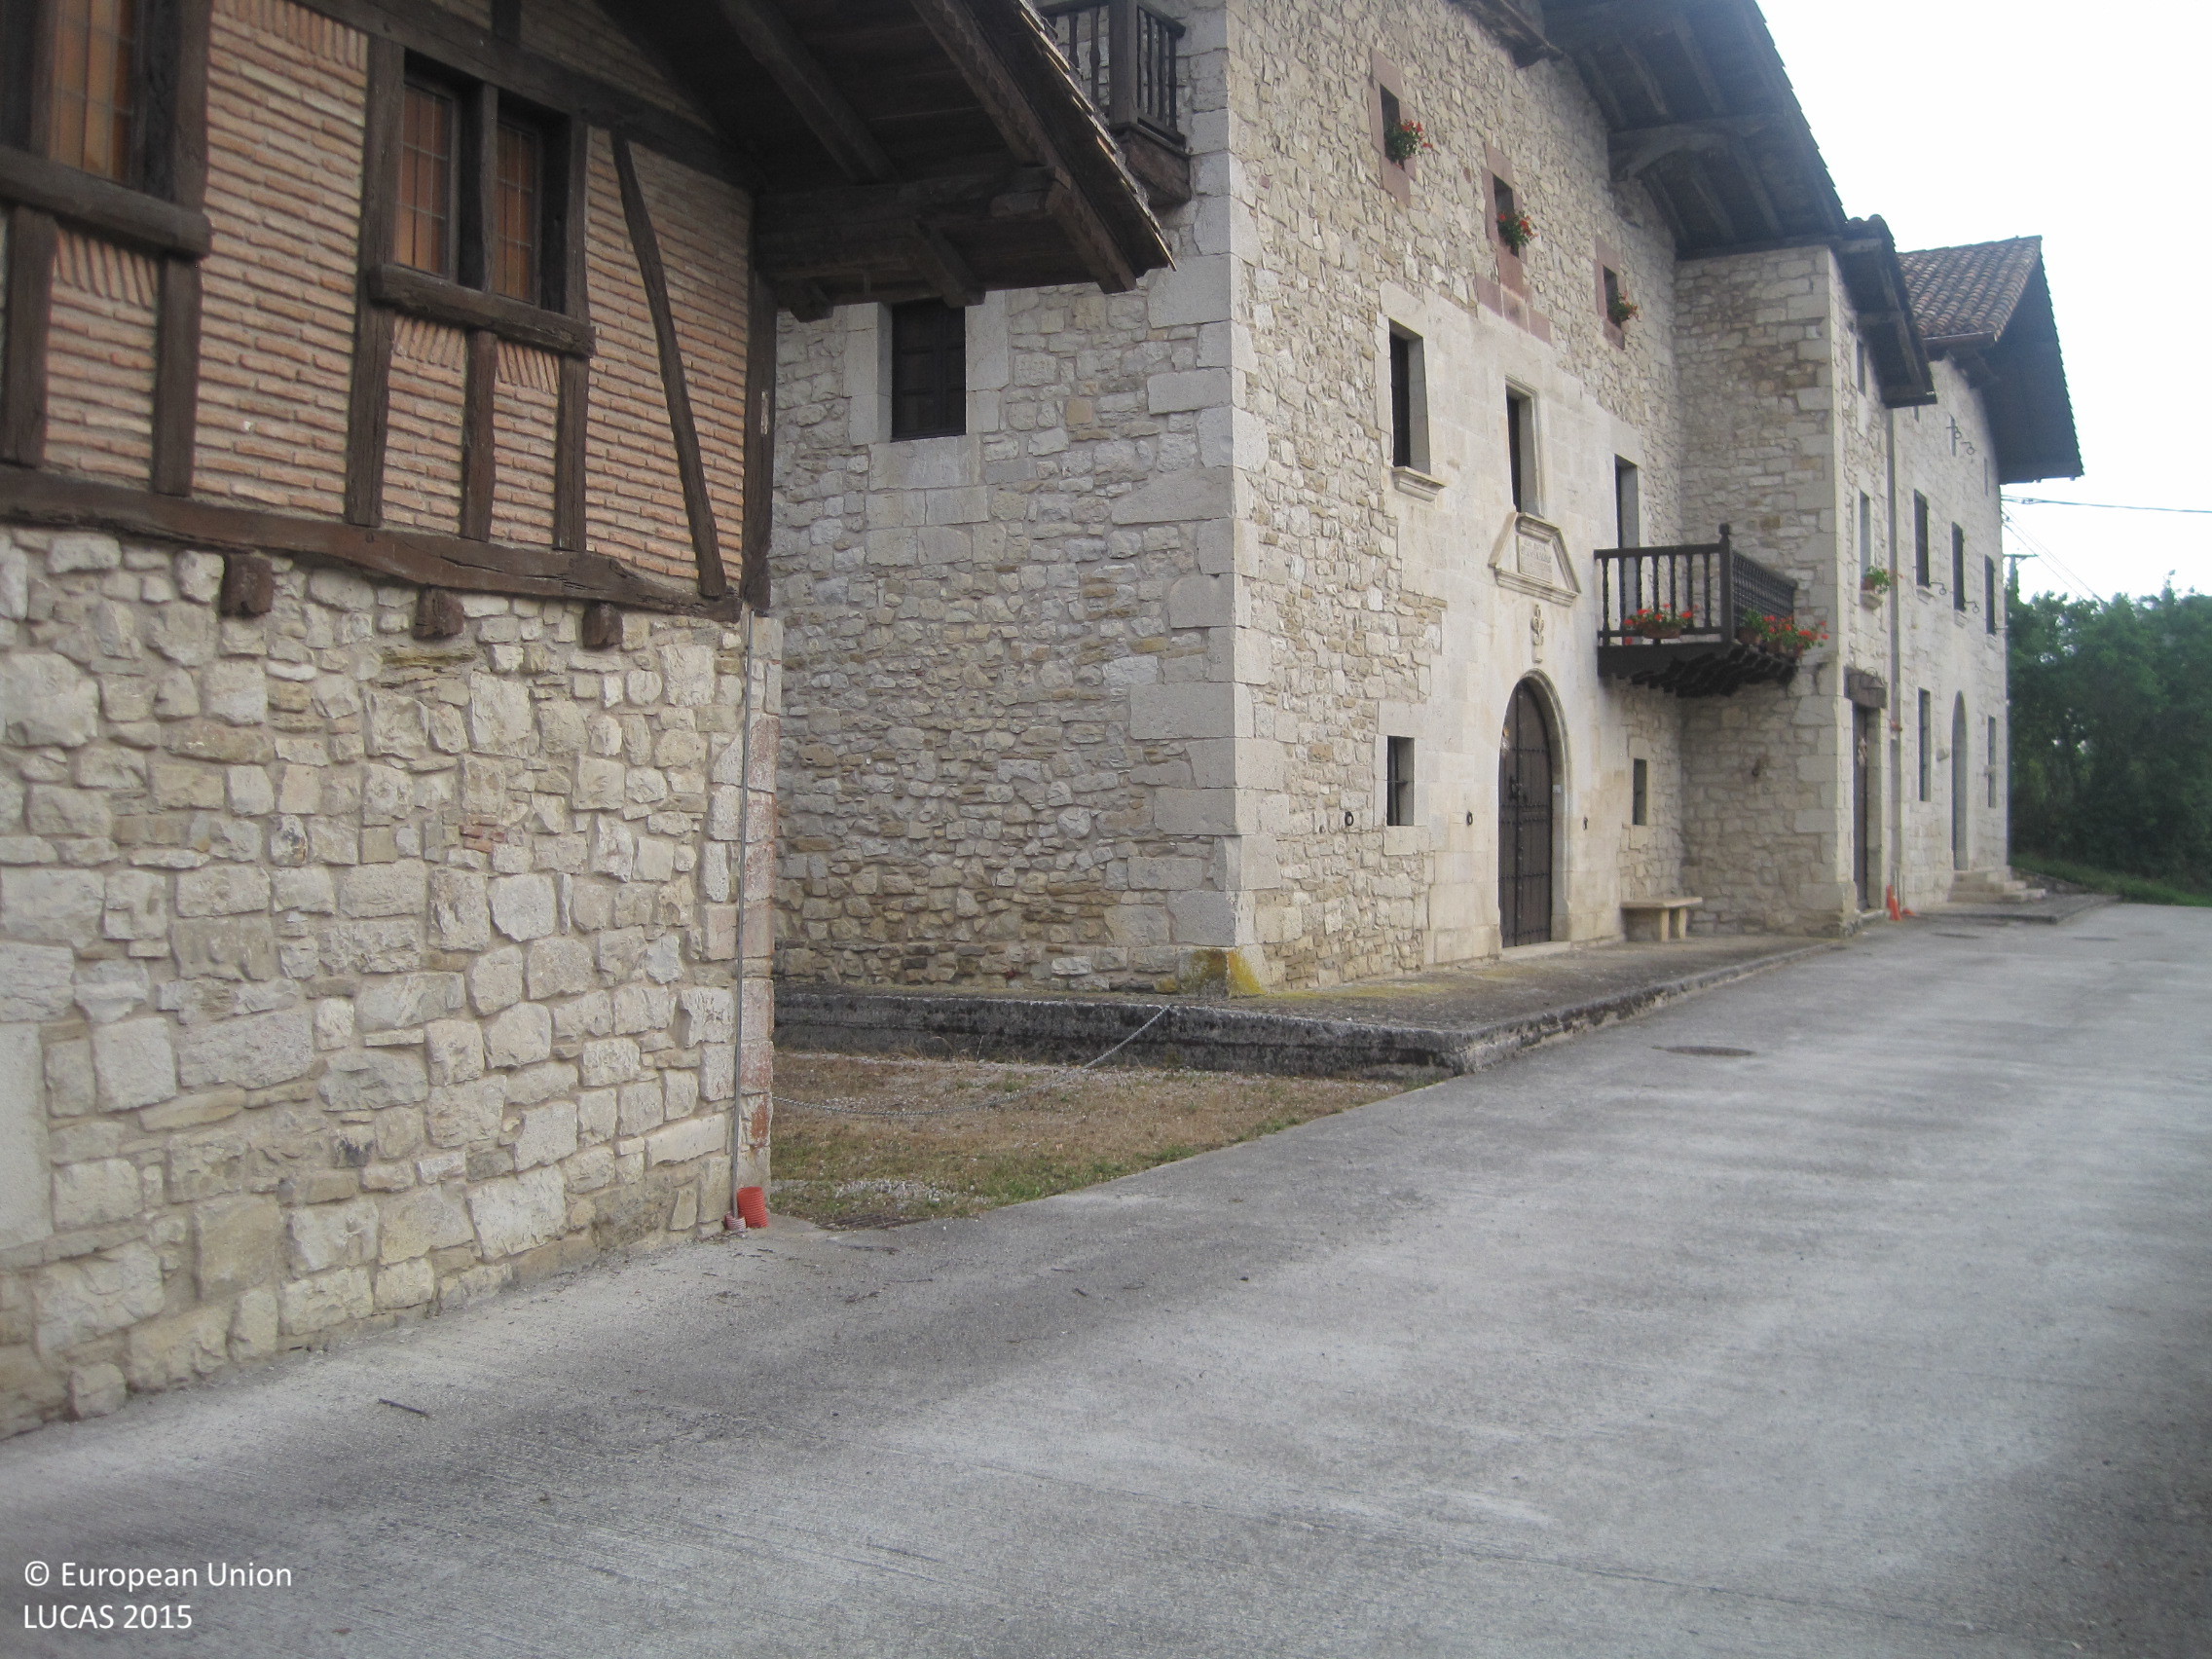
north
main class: Woodland
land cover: Broadleaved woodland
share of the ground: > 75 %
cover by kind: broadleaved forest trees 60 %, herbaceous plants 40 %
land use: Residential
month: June
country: ES
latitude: 42.9222
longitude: -1.6915
